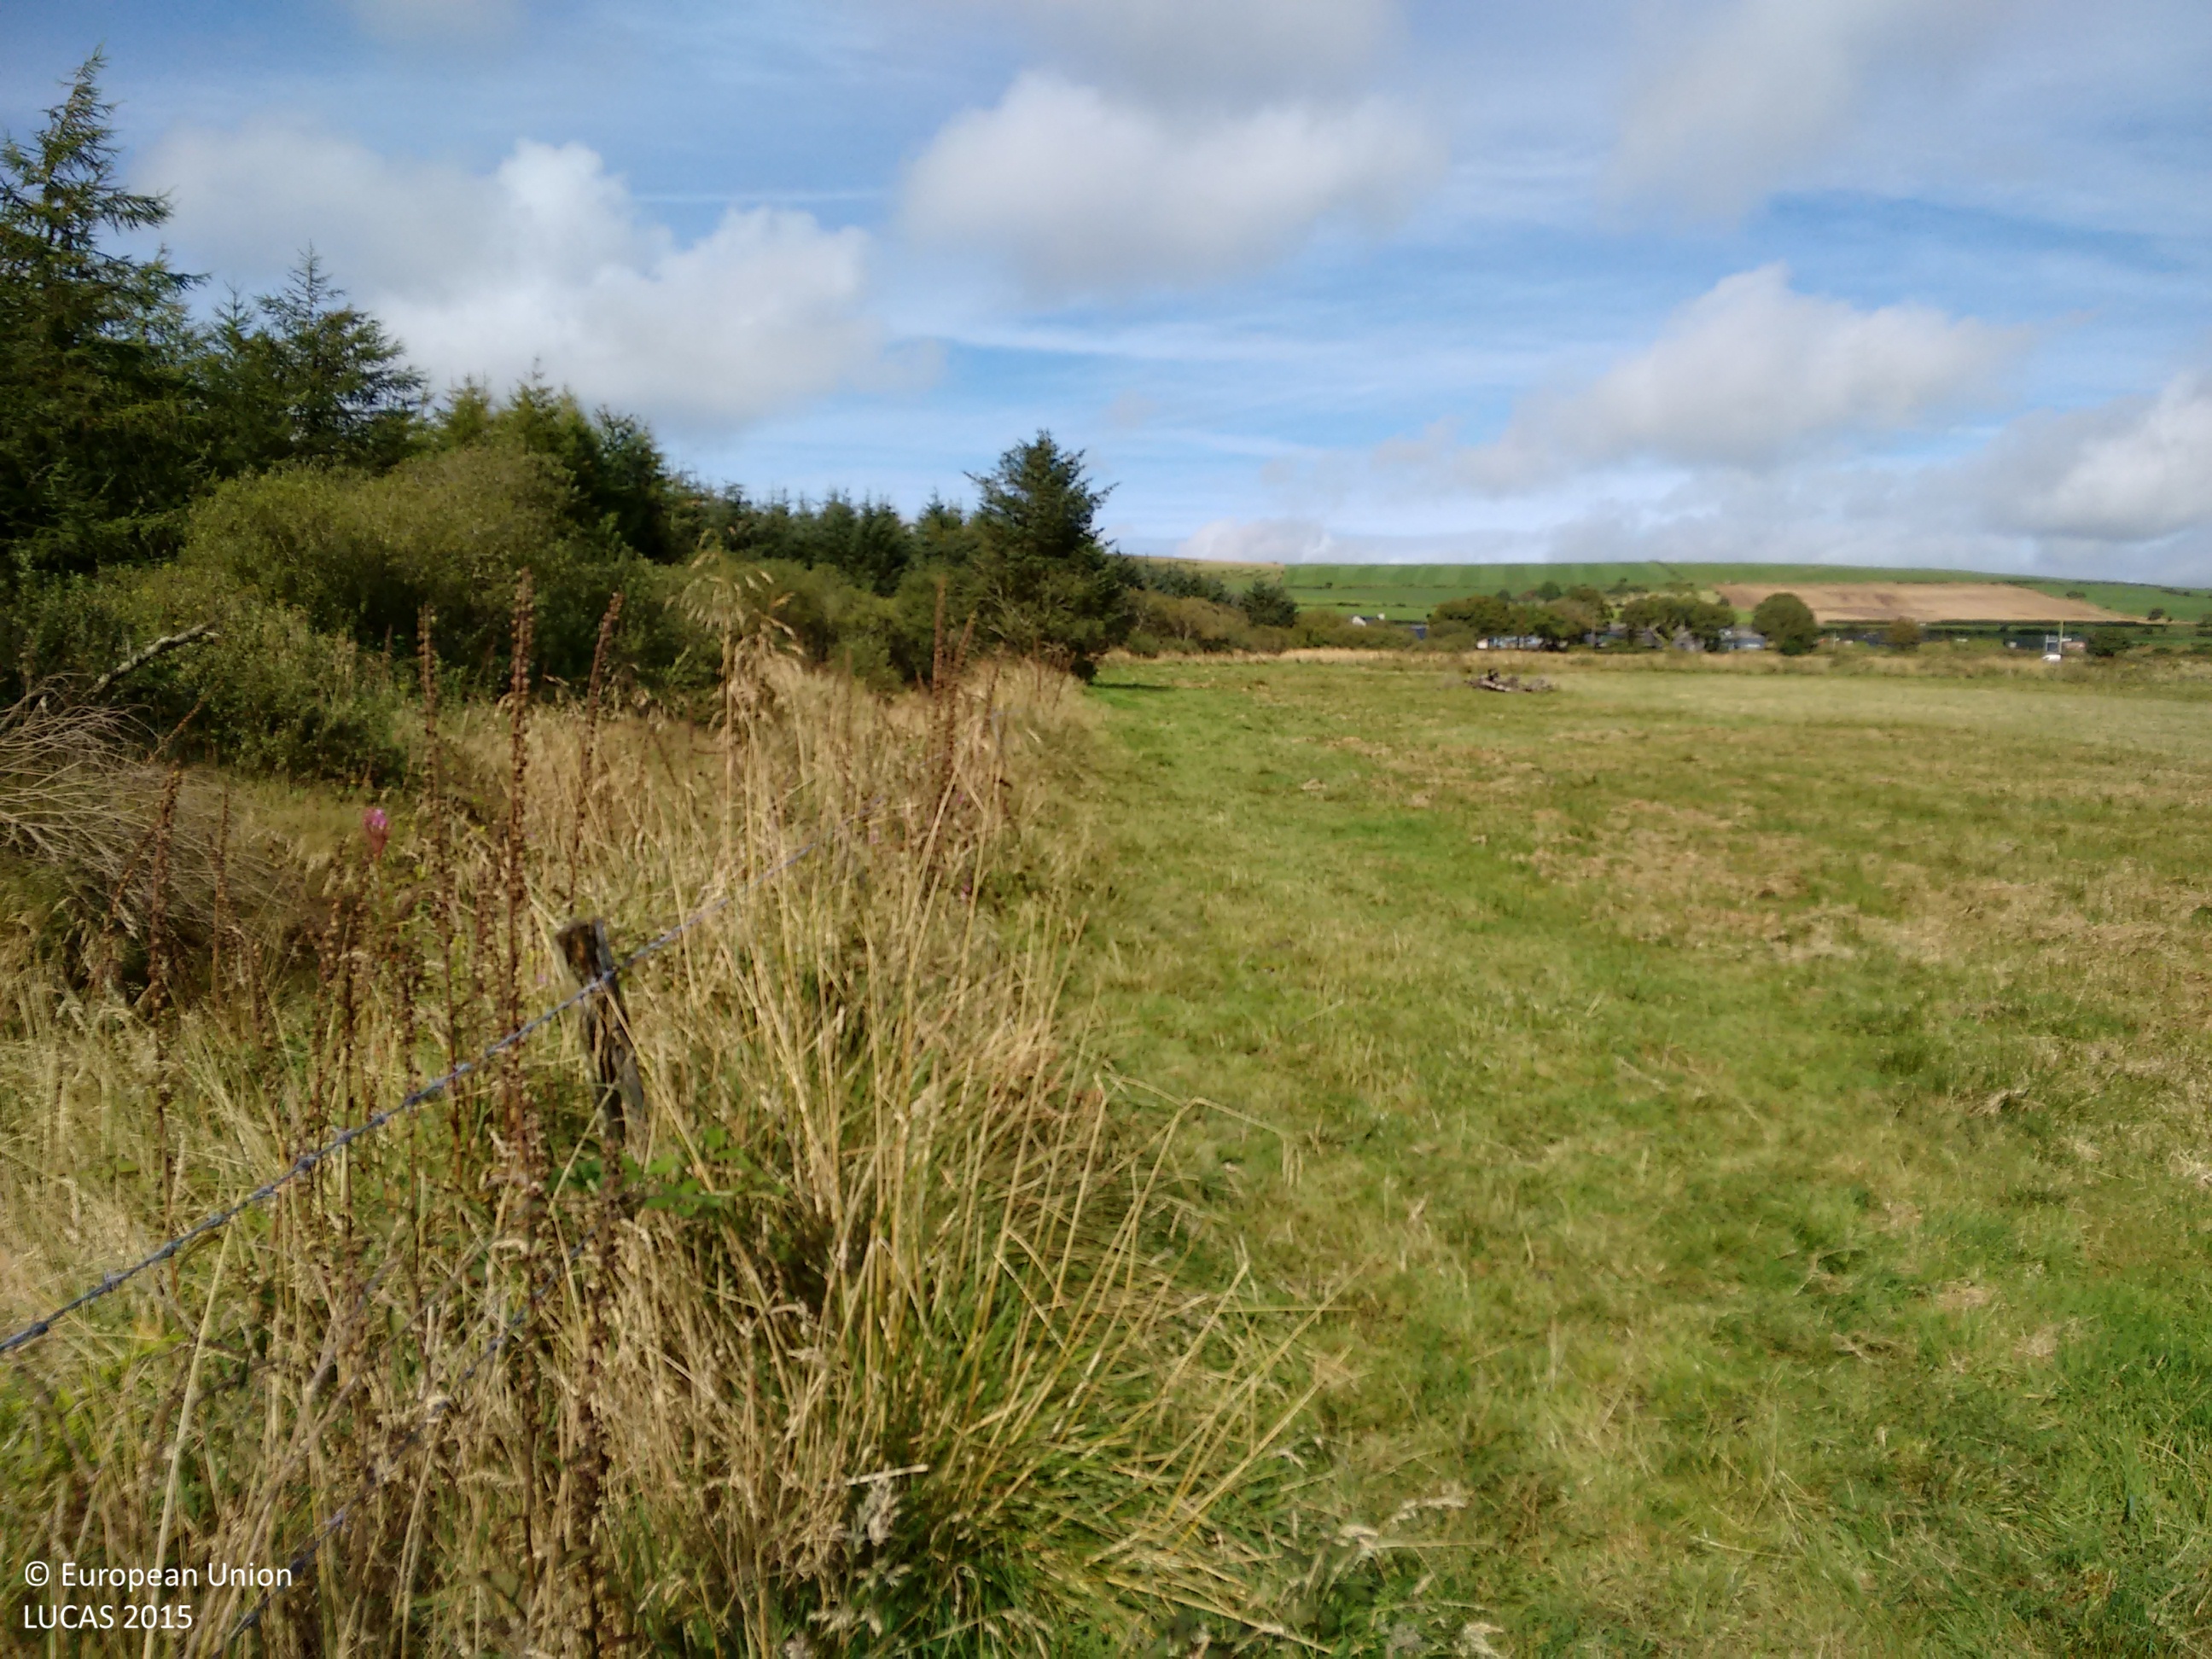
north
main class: Woodland
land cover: Spruce dominated coniferous woodland
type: exotic forest
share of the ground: > 75 %
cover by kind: coniferous forest trees 80 %, shrubs 20 %
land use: Forestry
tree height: > 5 m
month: August
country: GB
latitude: 51.9410
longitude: -4.9089
